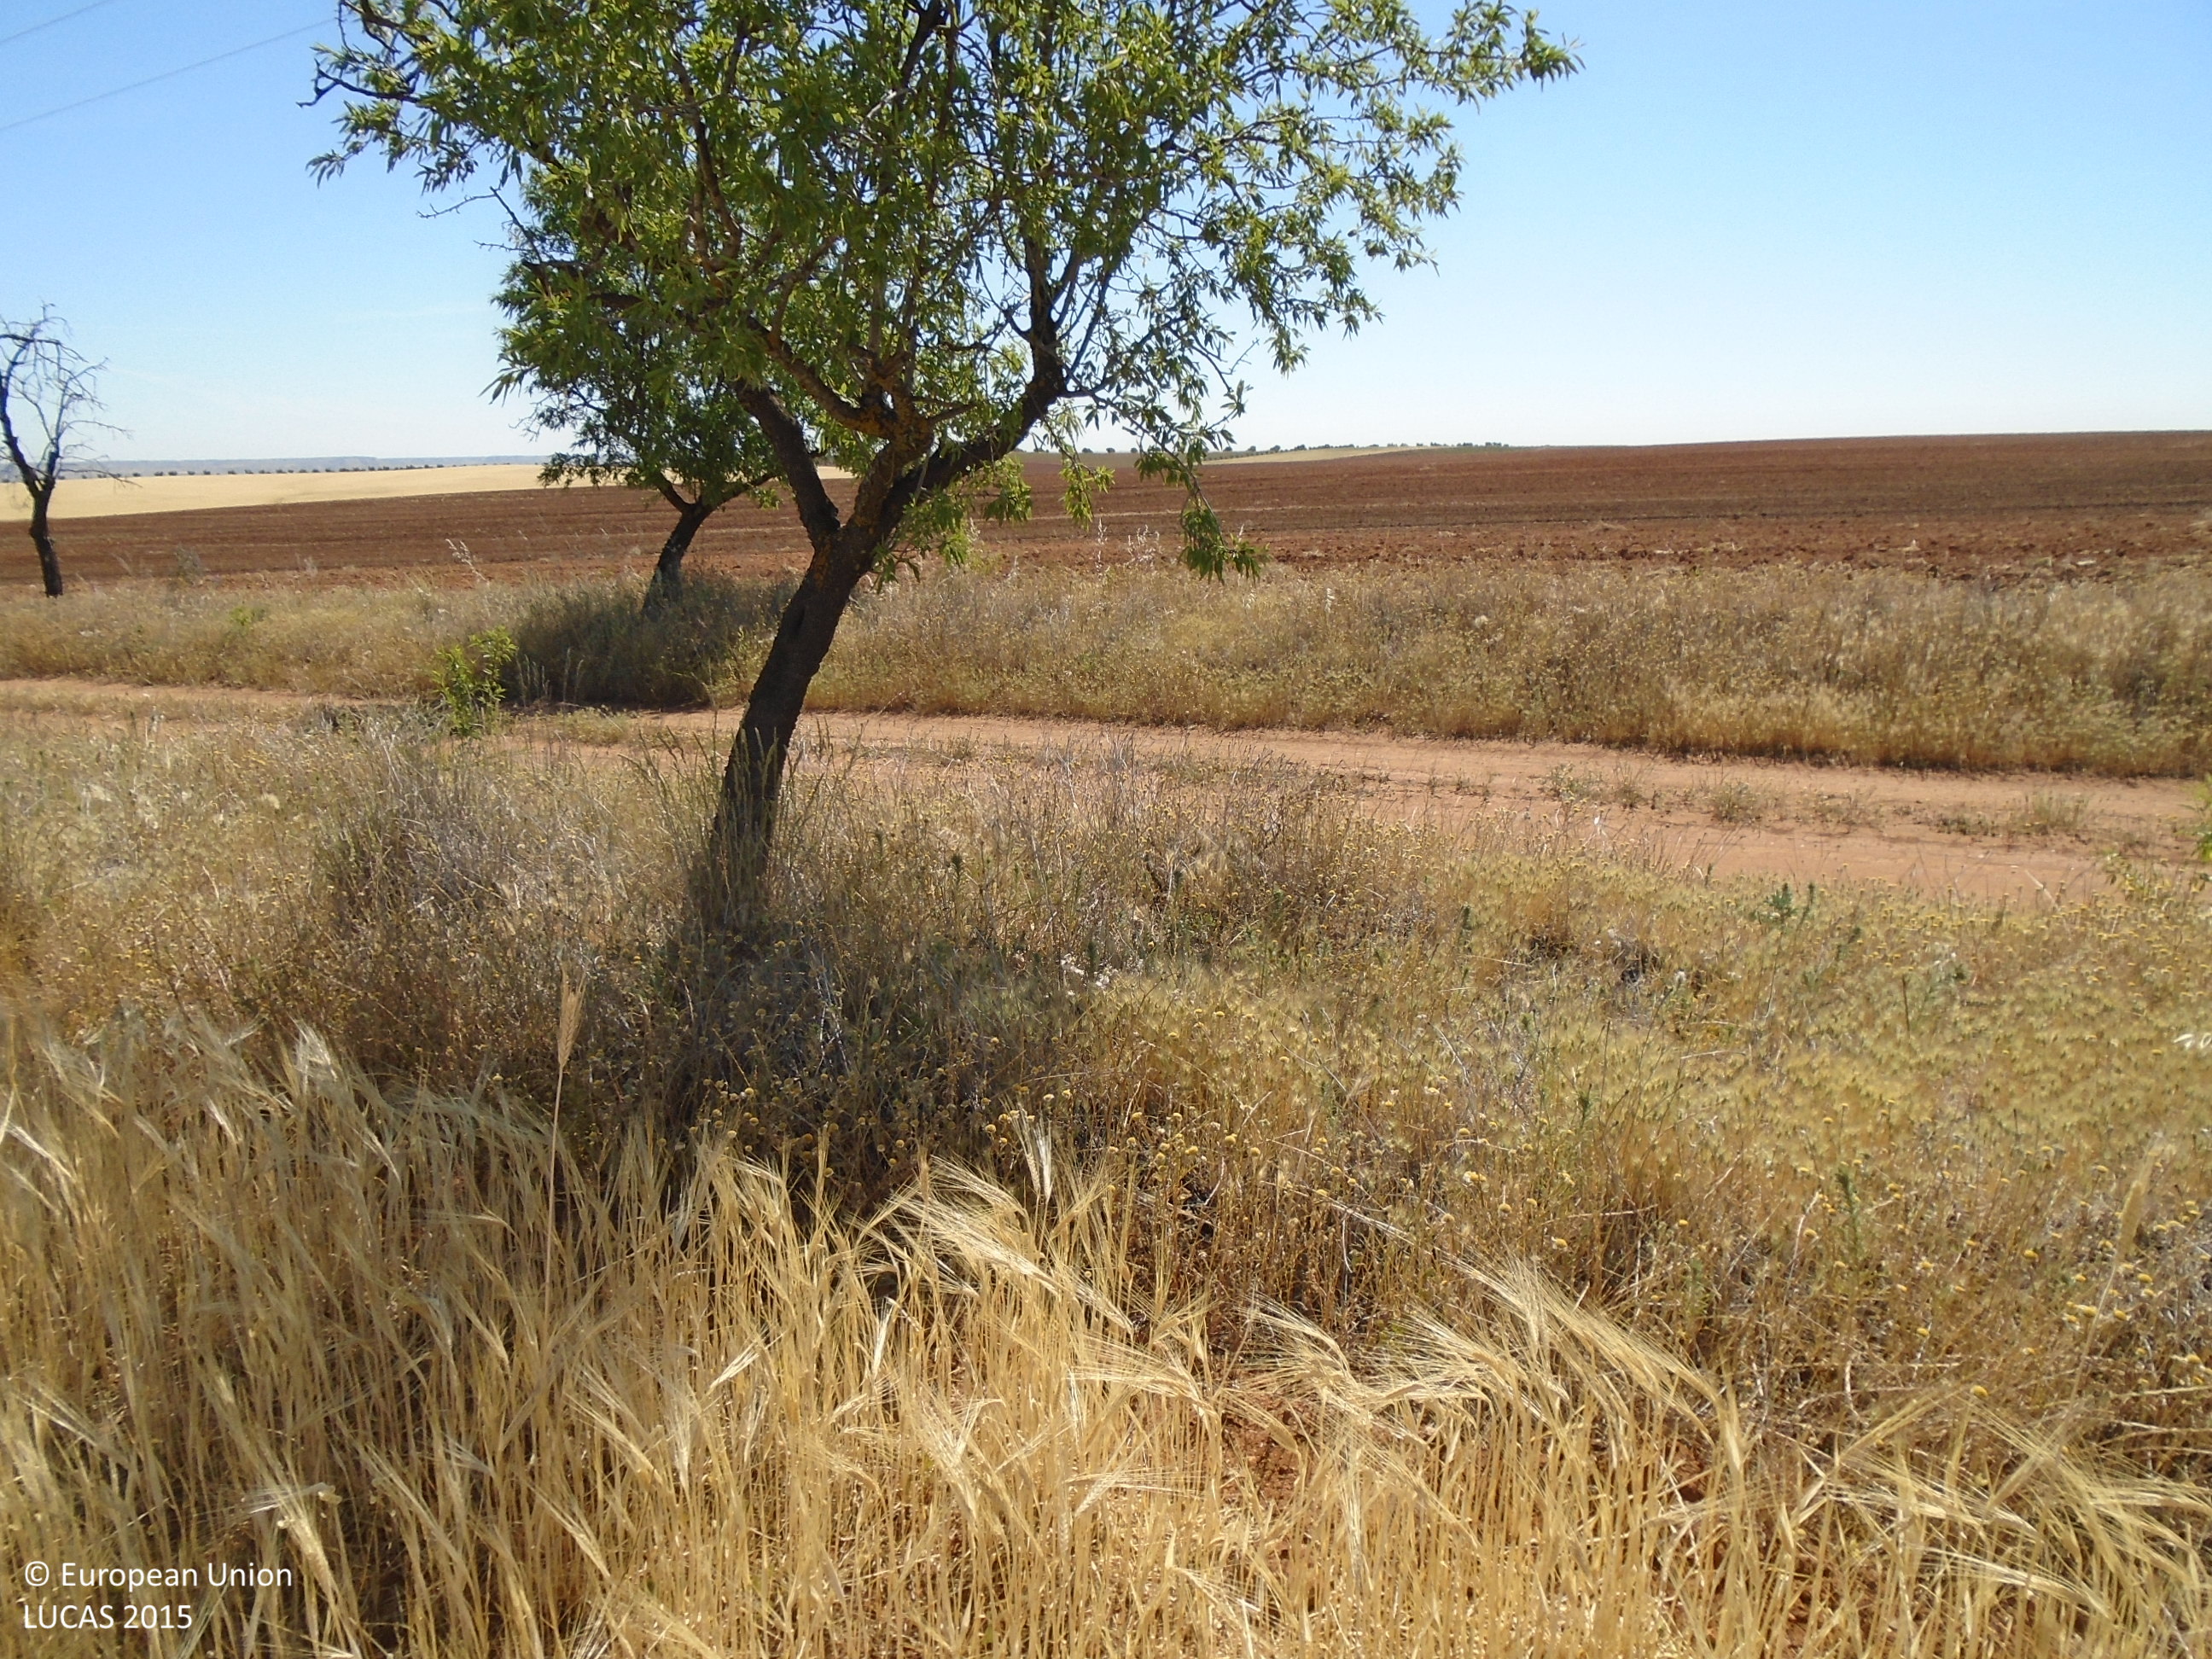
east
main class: Cropland
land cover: Barley
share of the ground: > 75 %
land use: Agriculture (excluding fallow land and kitchen gardens)
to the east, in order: Barley
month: May
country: ES
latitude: 39.7953
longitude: -3.7048
